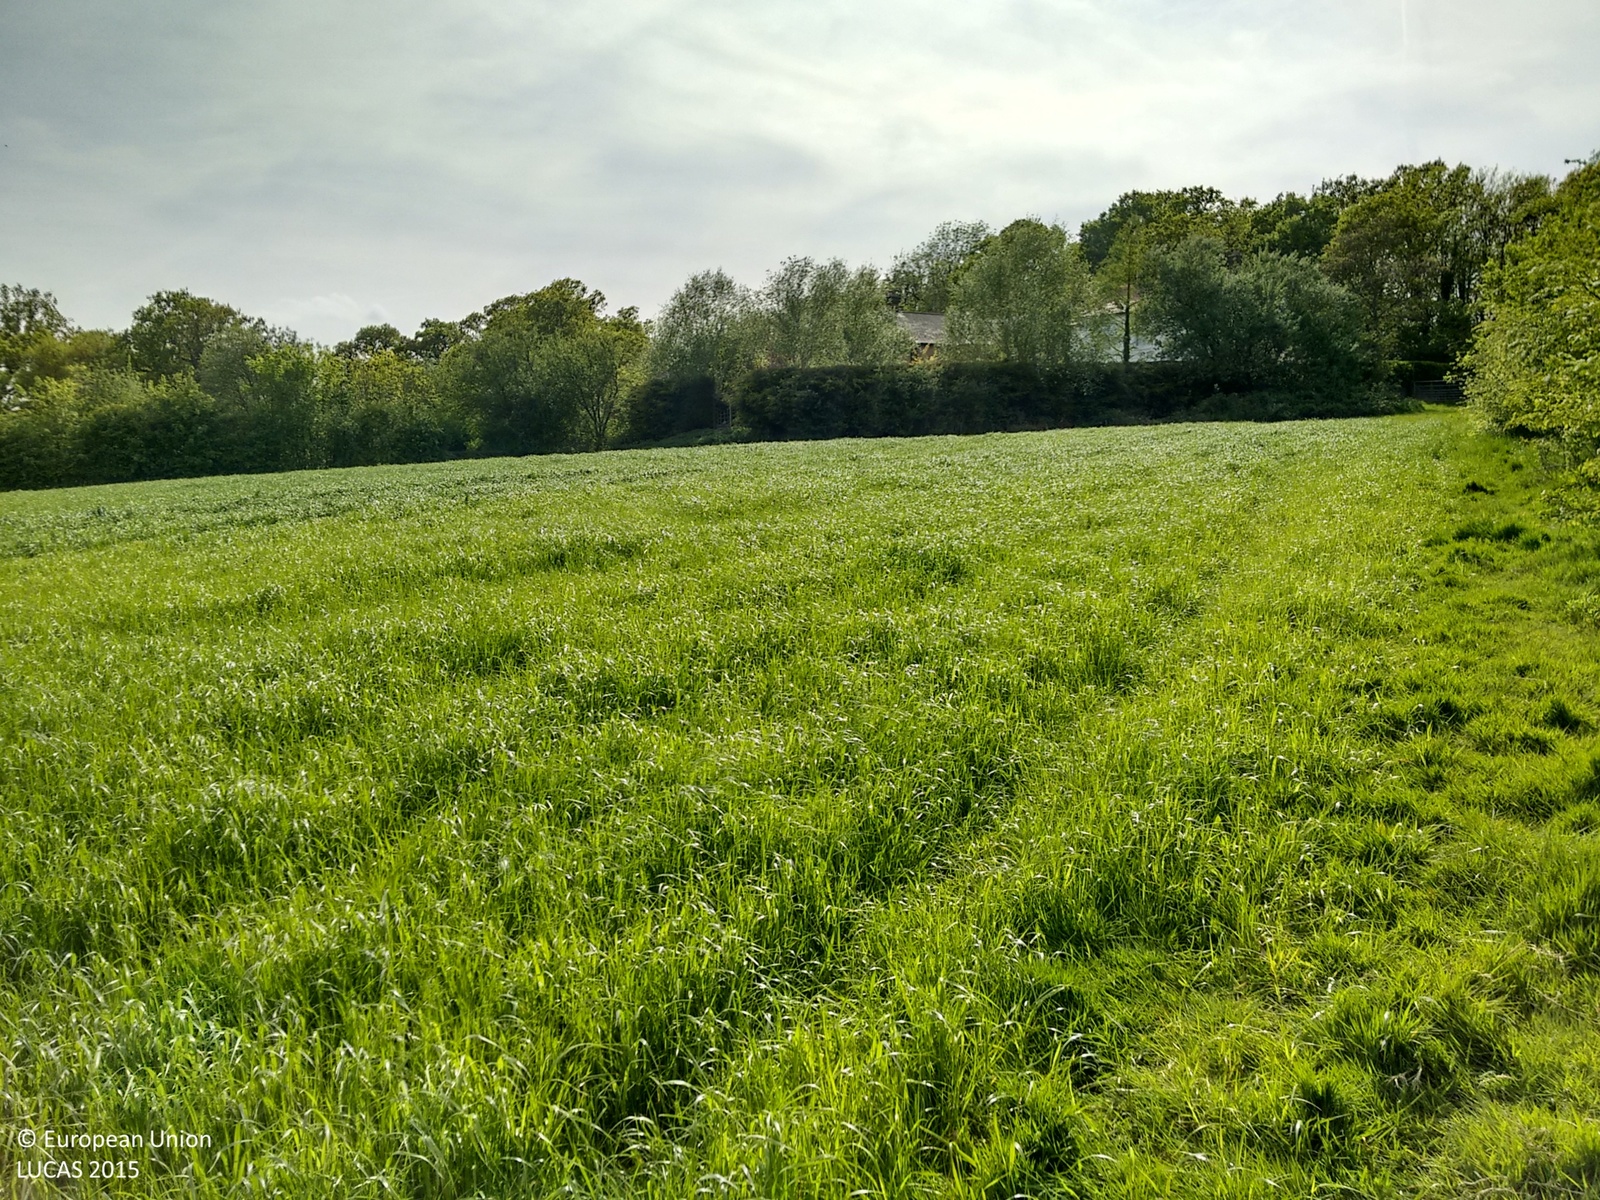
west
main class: Grassland
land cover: Grassland without tree/shrub cover
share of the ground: > 75 %
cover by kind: herbaceous plants 100 %
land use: Agriculture (excluding fallow land and kitchen gardens)
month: May
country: GB
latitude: 51.2783
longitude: 0.5829
